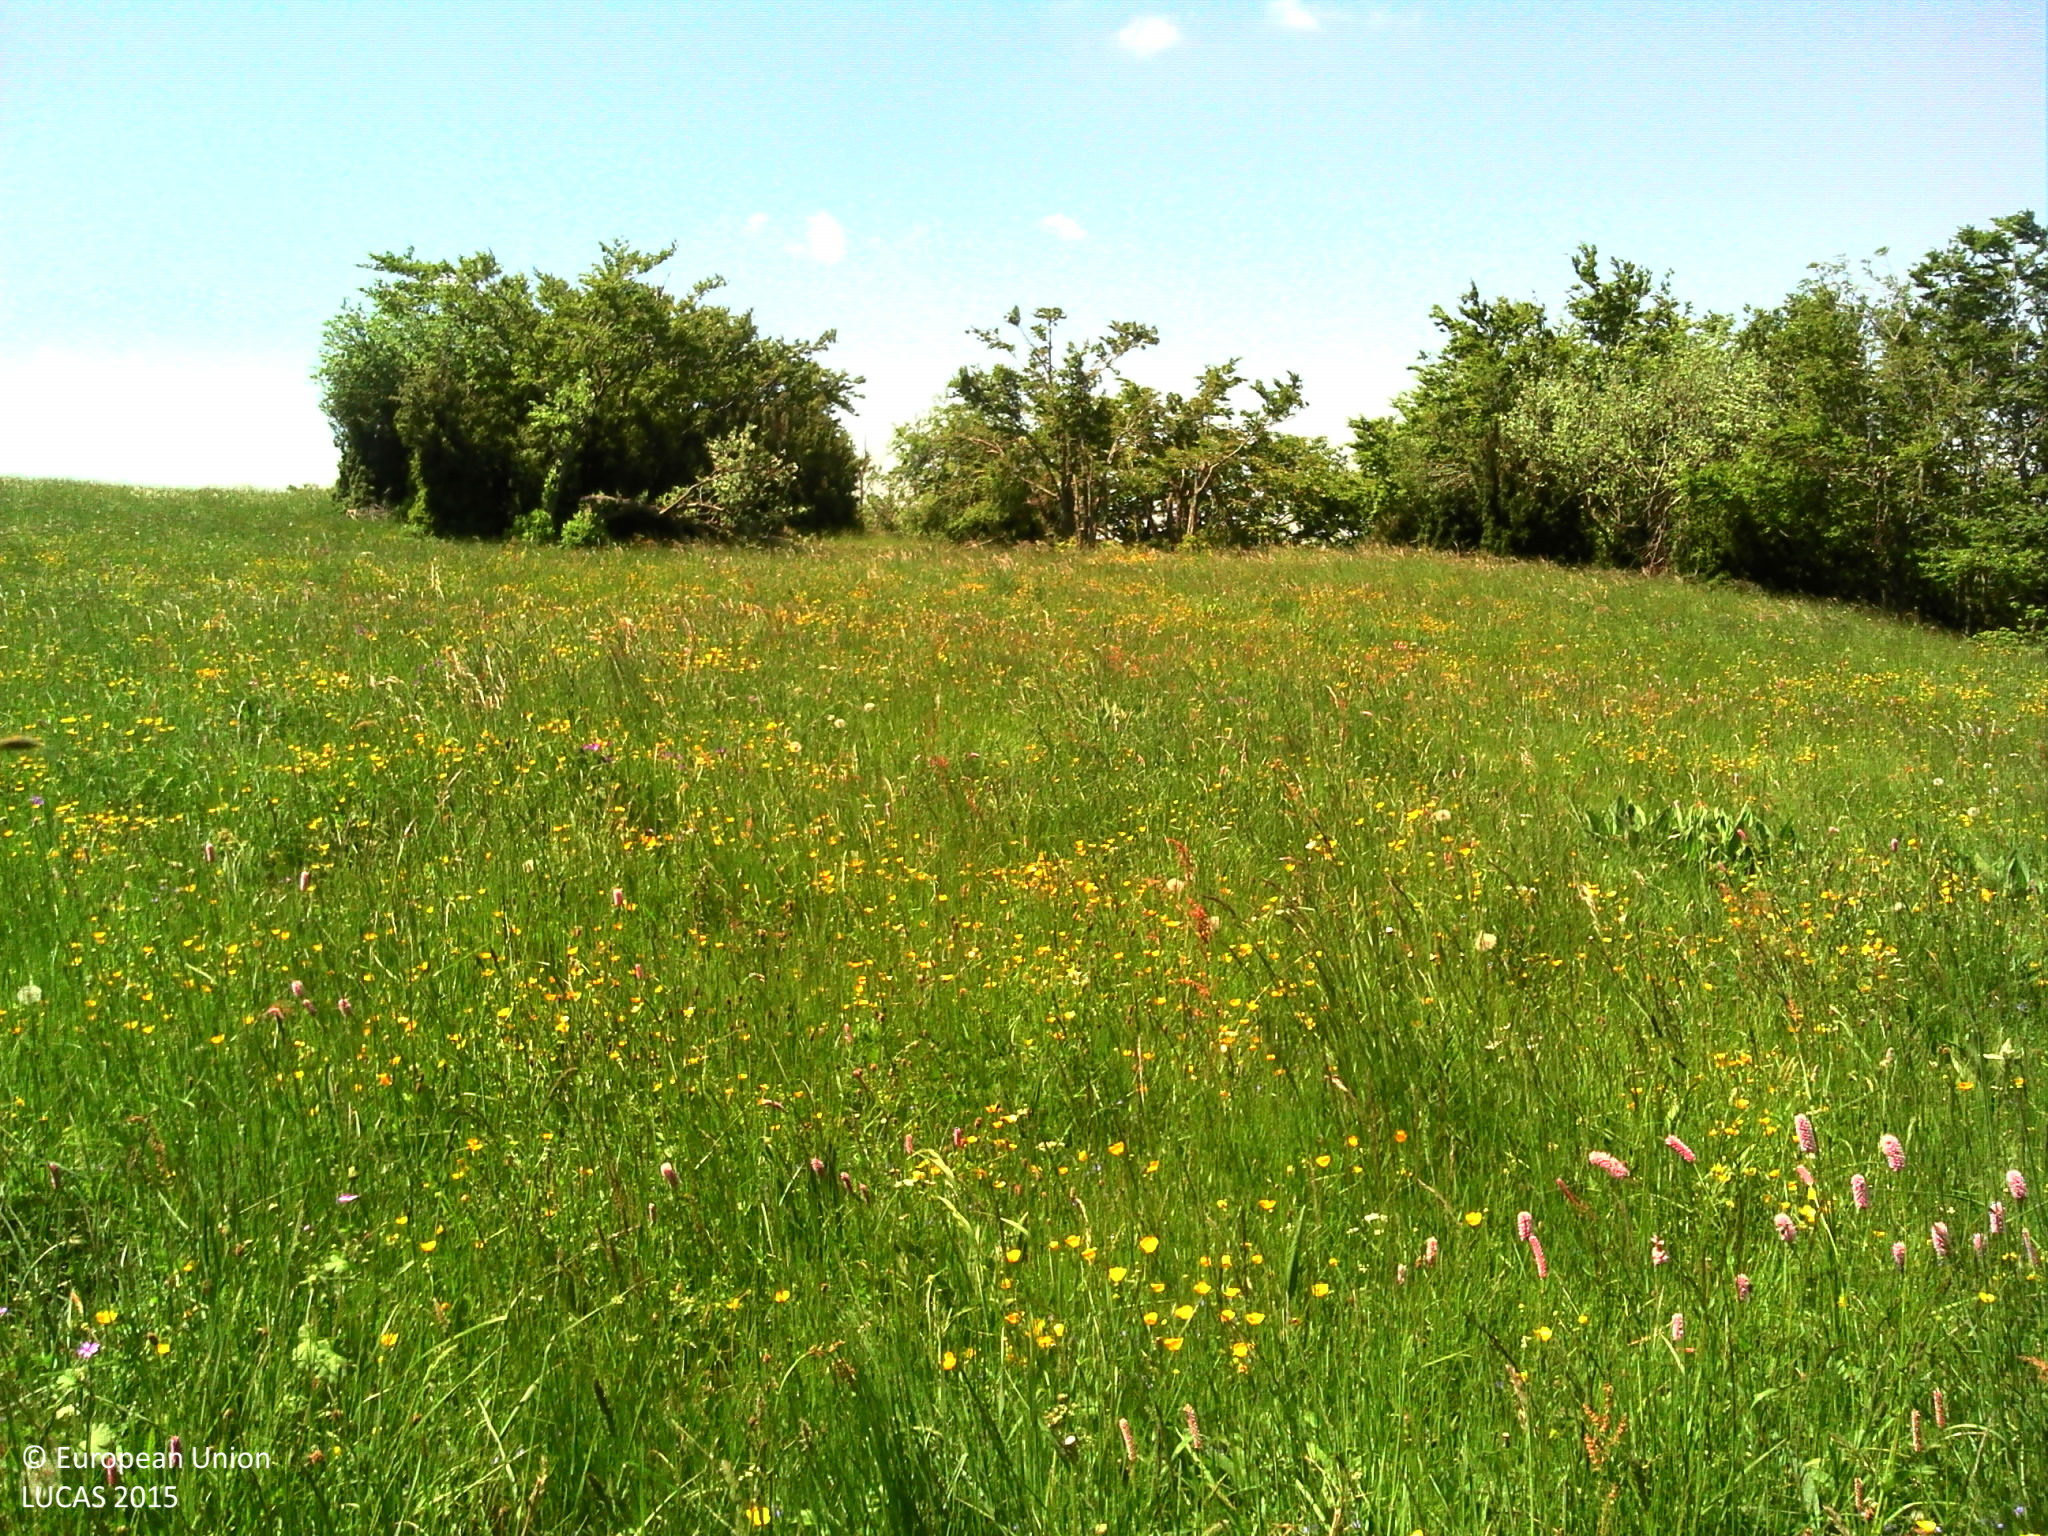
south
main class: Grassland
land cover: Grassland with sparse tree/shrub cover
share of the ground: > 75 %
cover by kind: herbaceous plants 95 %, broadleaved forest trees 5 %
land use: Agriculture (excluding fallow land and kitchen gardens)
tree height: < 5 m
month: June
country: FR
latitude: 44.9081
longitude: 5.2057
